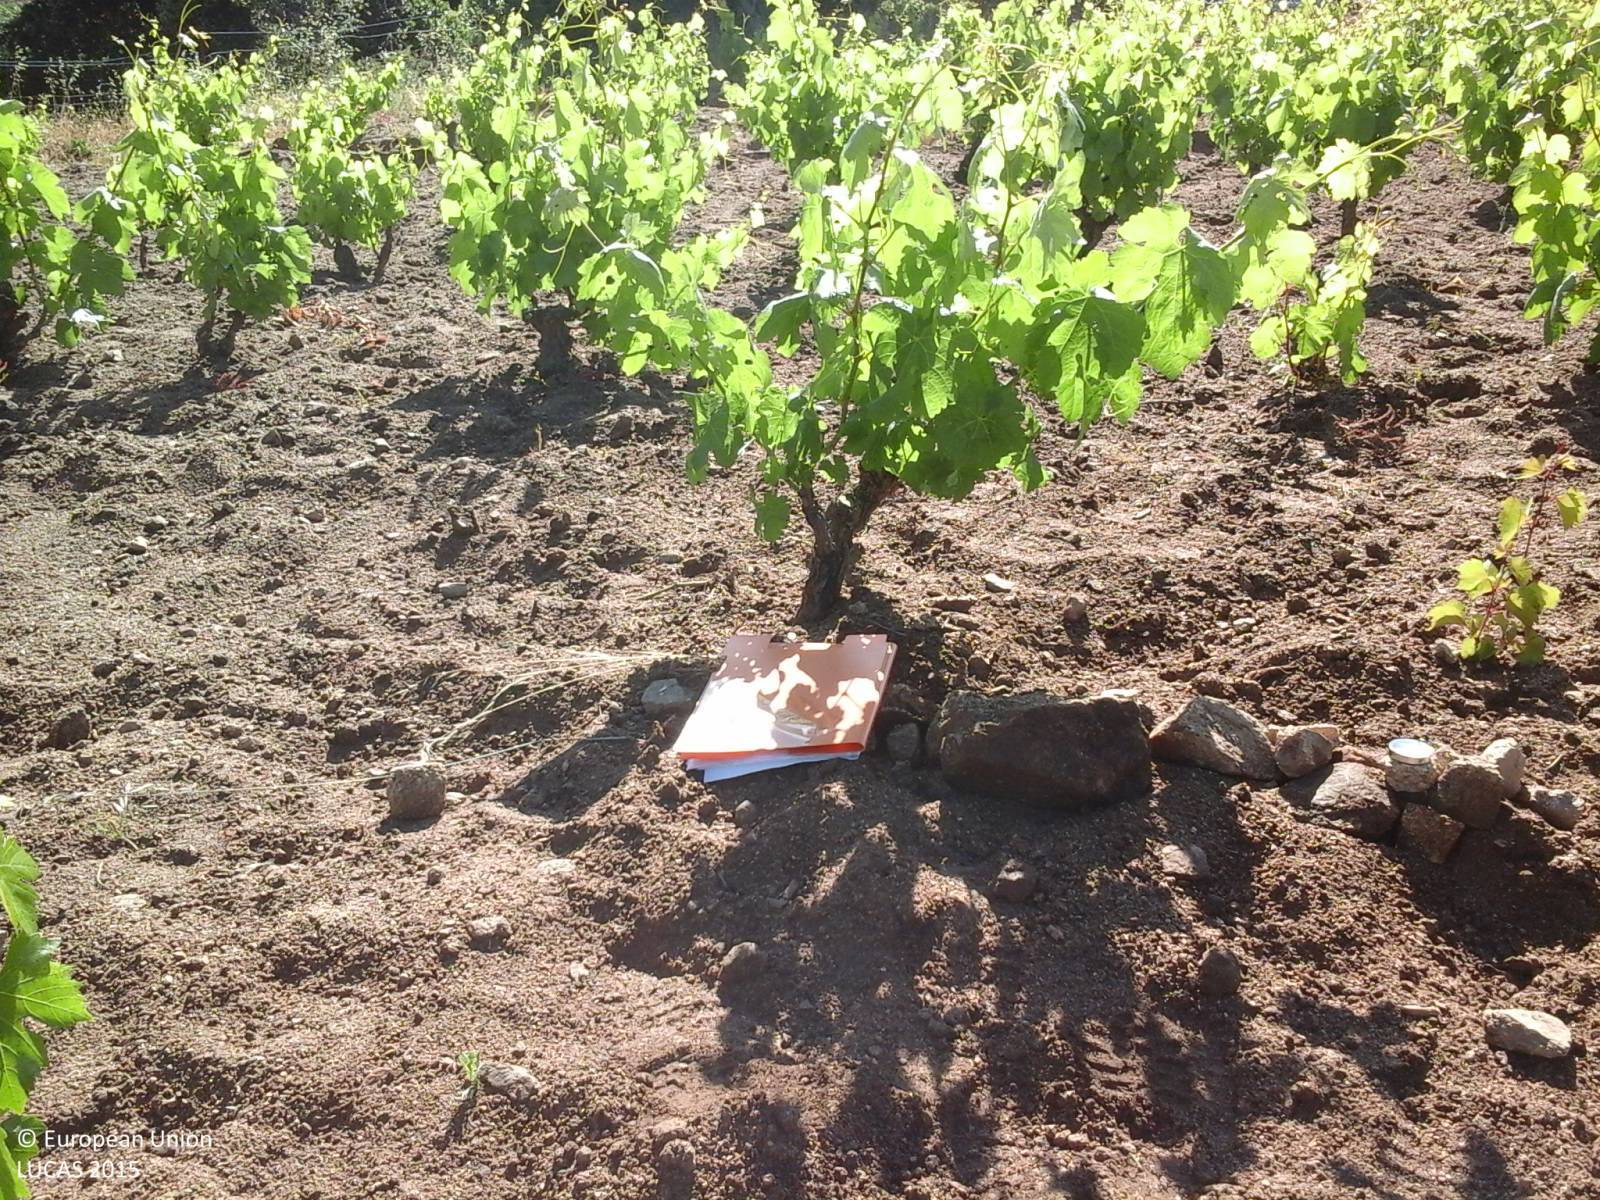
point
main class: Cropland
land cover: Vineyards
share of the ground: 50 - 75 %
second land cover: Other bare soil
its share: > 75 %
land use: Agriculture (excluding fallow land and kitchen gardens)
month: May
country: IT
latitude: 40.2293
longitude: 9.4038
